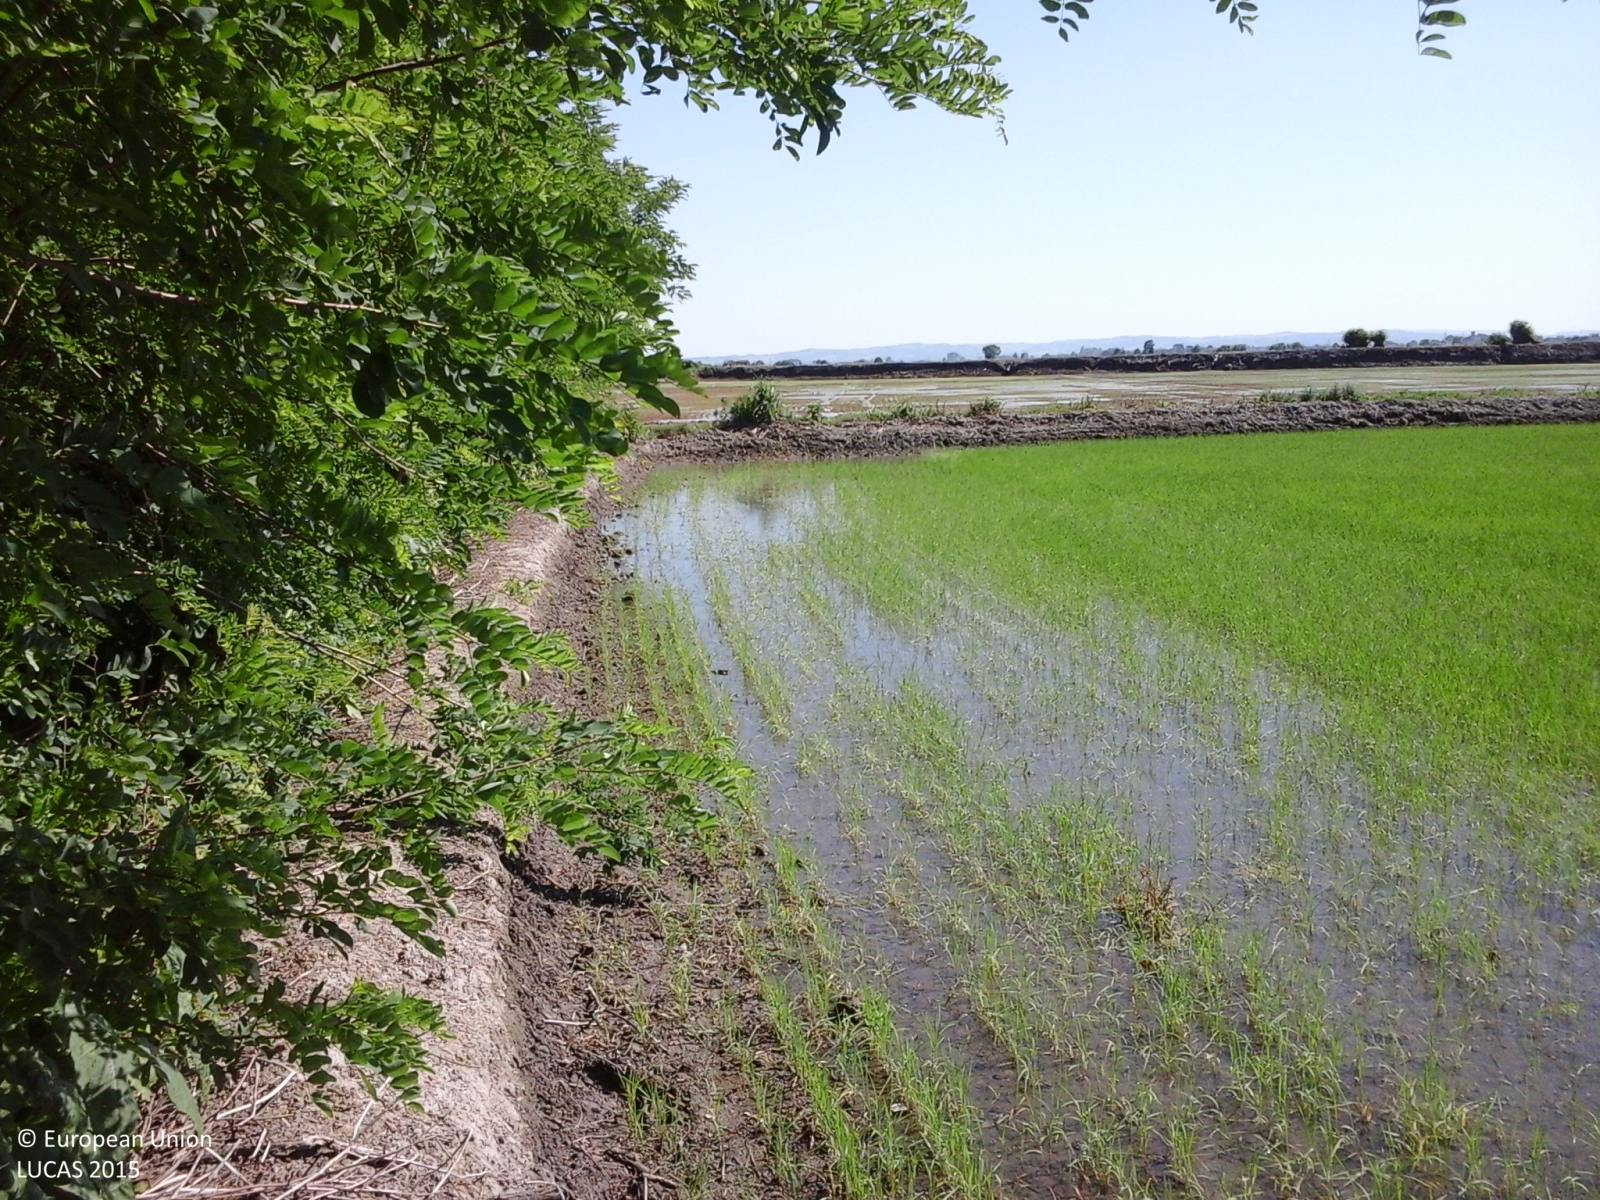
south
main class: Cropland
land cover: Rice
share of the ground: 50 - 75 %
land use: Agriculture (excluding fallow land and kitchen gardens)
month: May
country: IT
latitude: 45.2585
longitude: 8.4353
